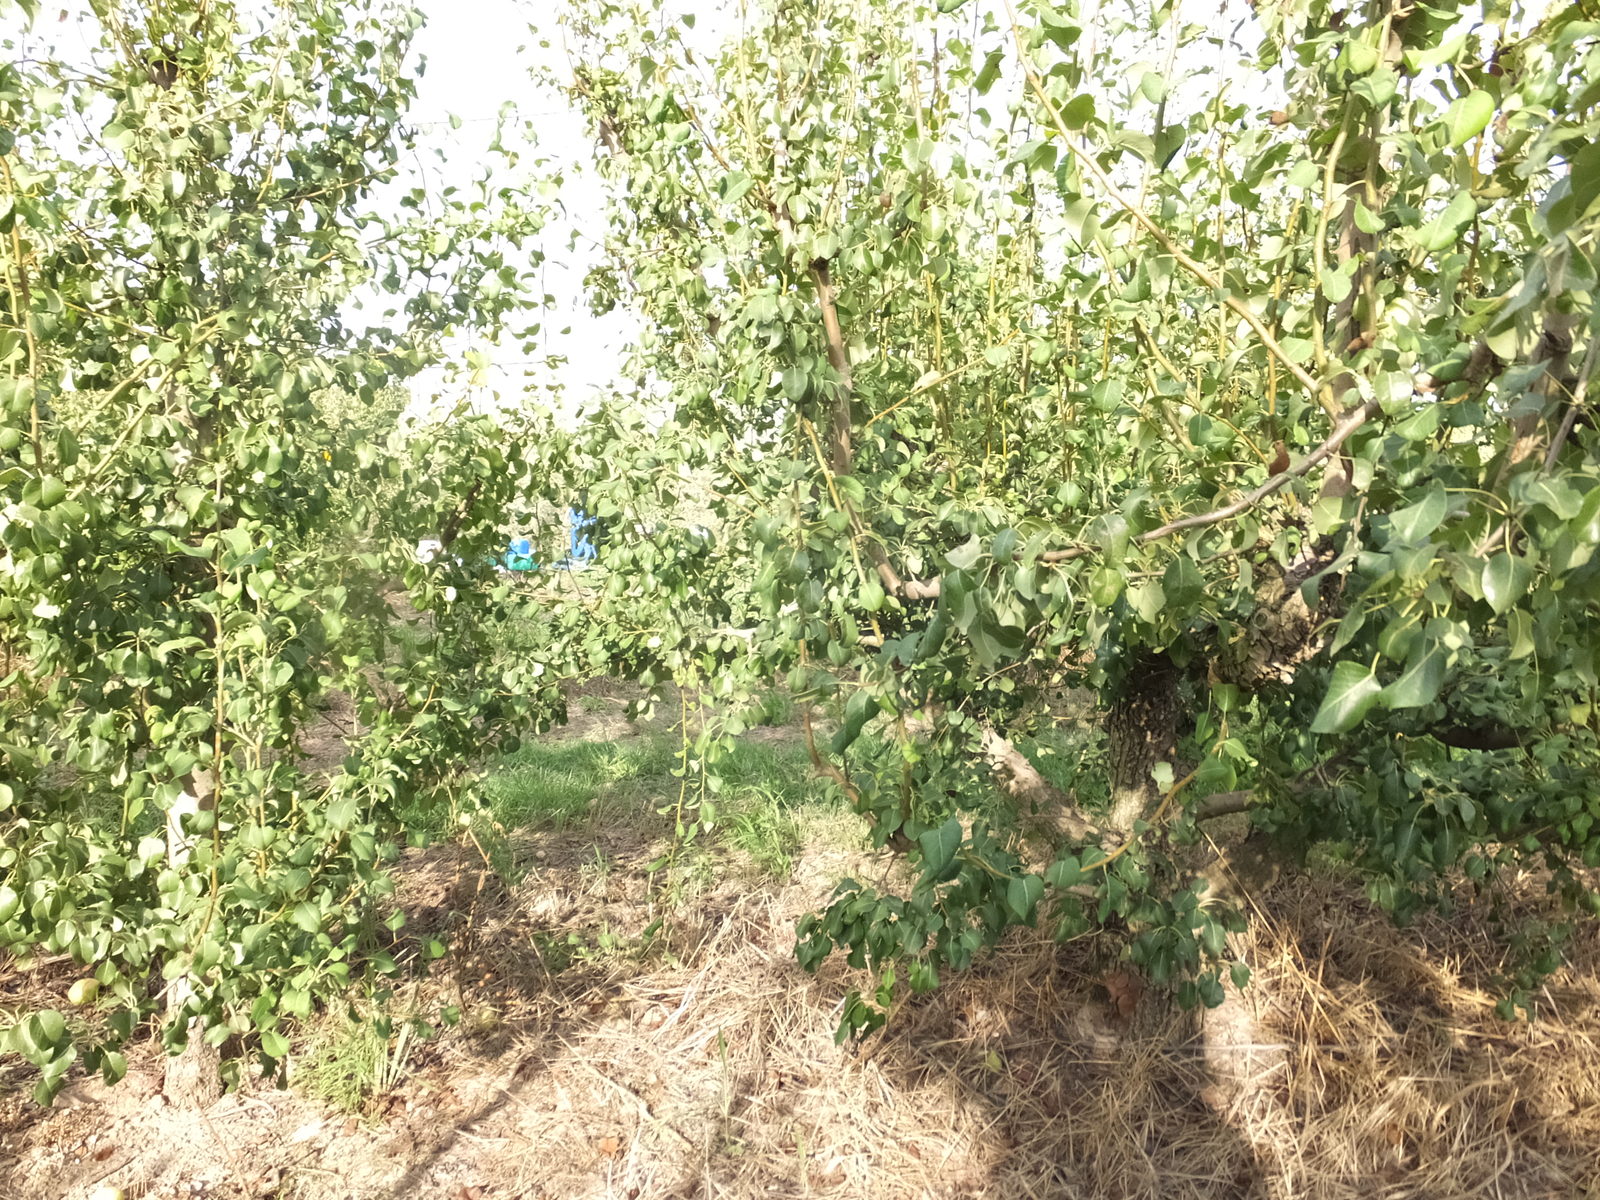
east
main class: Cropland
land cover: Pear fruit
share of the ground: > 75 %
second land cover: Spontaneously vegetated surfaces
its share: 10 - 25 %
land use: Agriculture (excluding fallow land and kitchen gardens)
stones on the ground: < 10 %
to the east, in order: Pear fruit; Spontaneously vegetated surfaces; Tracks; Grass margins; Pear fruit; Grass margins; Tracks; Spontaneously vegetated surfaces; Pear fruit; Grass margins; Tracks; Grass margins; Tracks; Shruby margins; Other fruit trees and berries; Artificial constructions in urban areas; Other fruit trees and berries
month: August
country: ES
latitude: 41.5278
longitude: 0.4358
